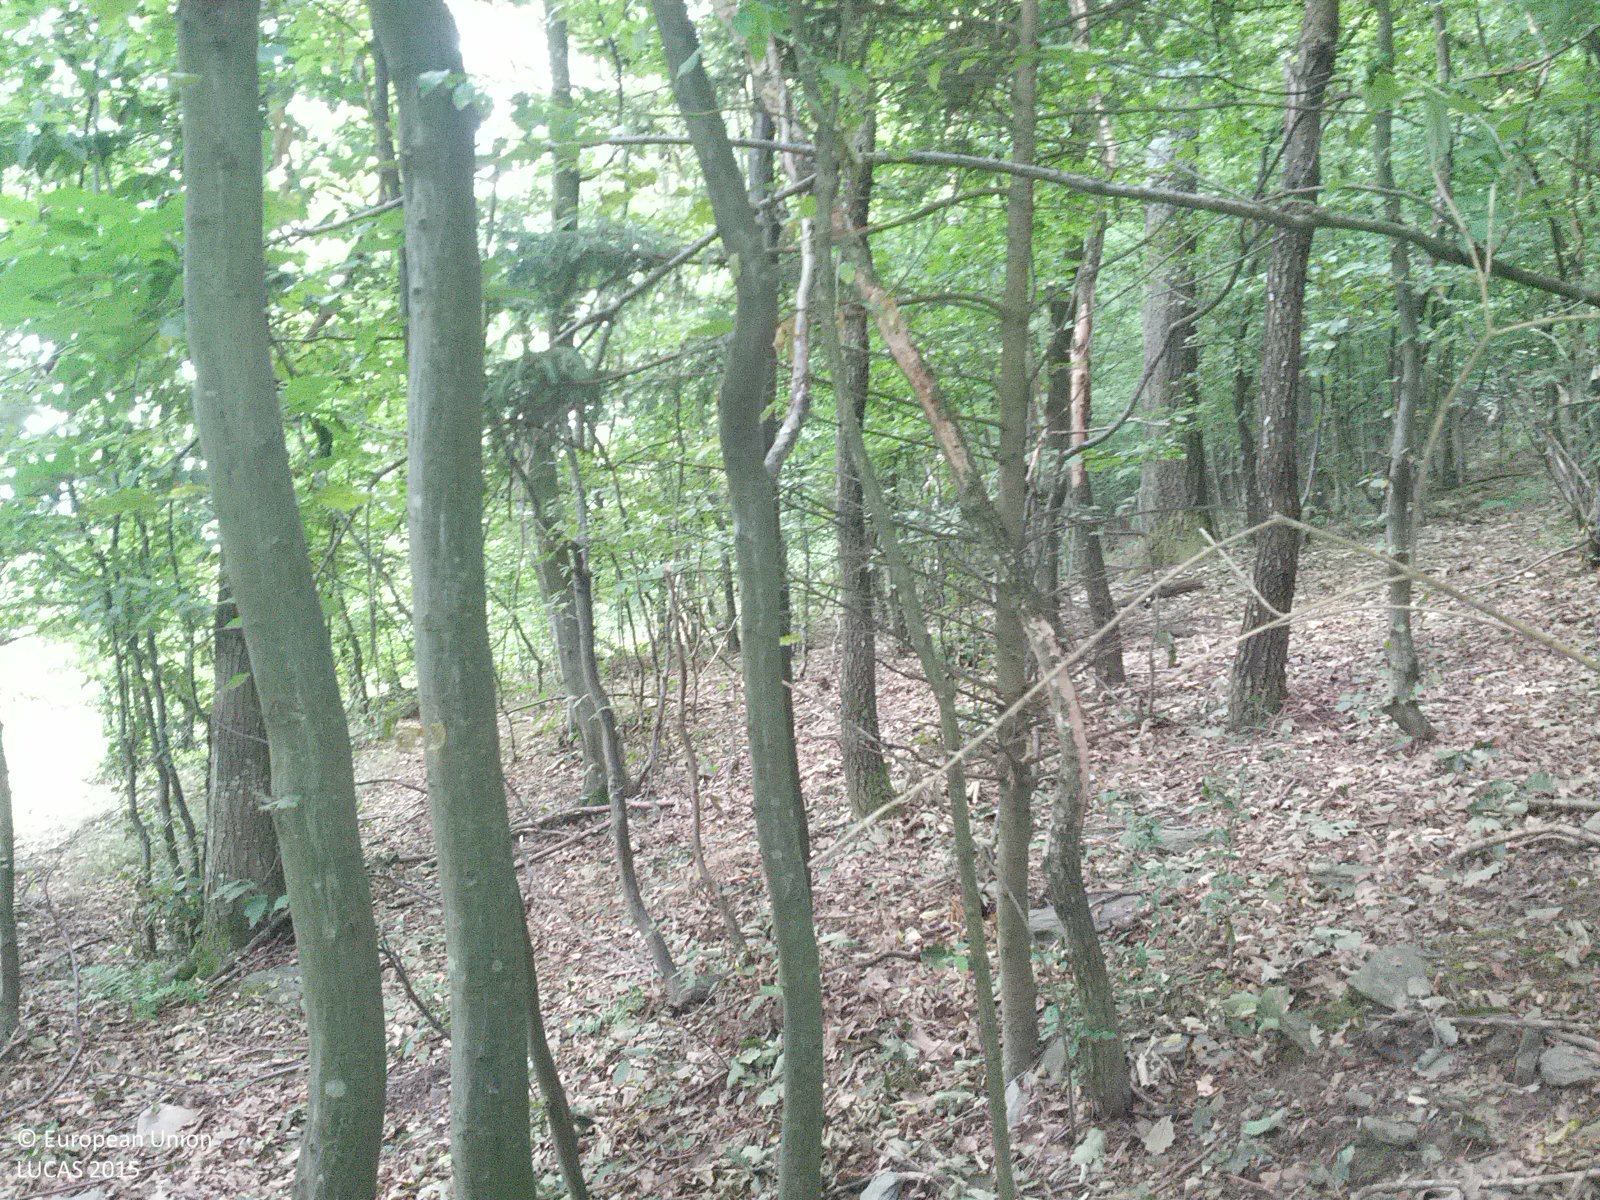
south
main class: Woodland
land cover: Spruce dominated mixed woodland
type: alpine coniferous forest
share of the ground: > 75 %
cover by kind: coniferous forest trees 55 %, broadleaved forest trees 35 %, shrubs 5 %, unconsolidated bare surface 5 %
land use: Forestry
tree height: > 5 m
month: July
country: AT
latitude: 47.3143
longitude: 16.4190
